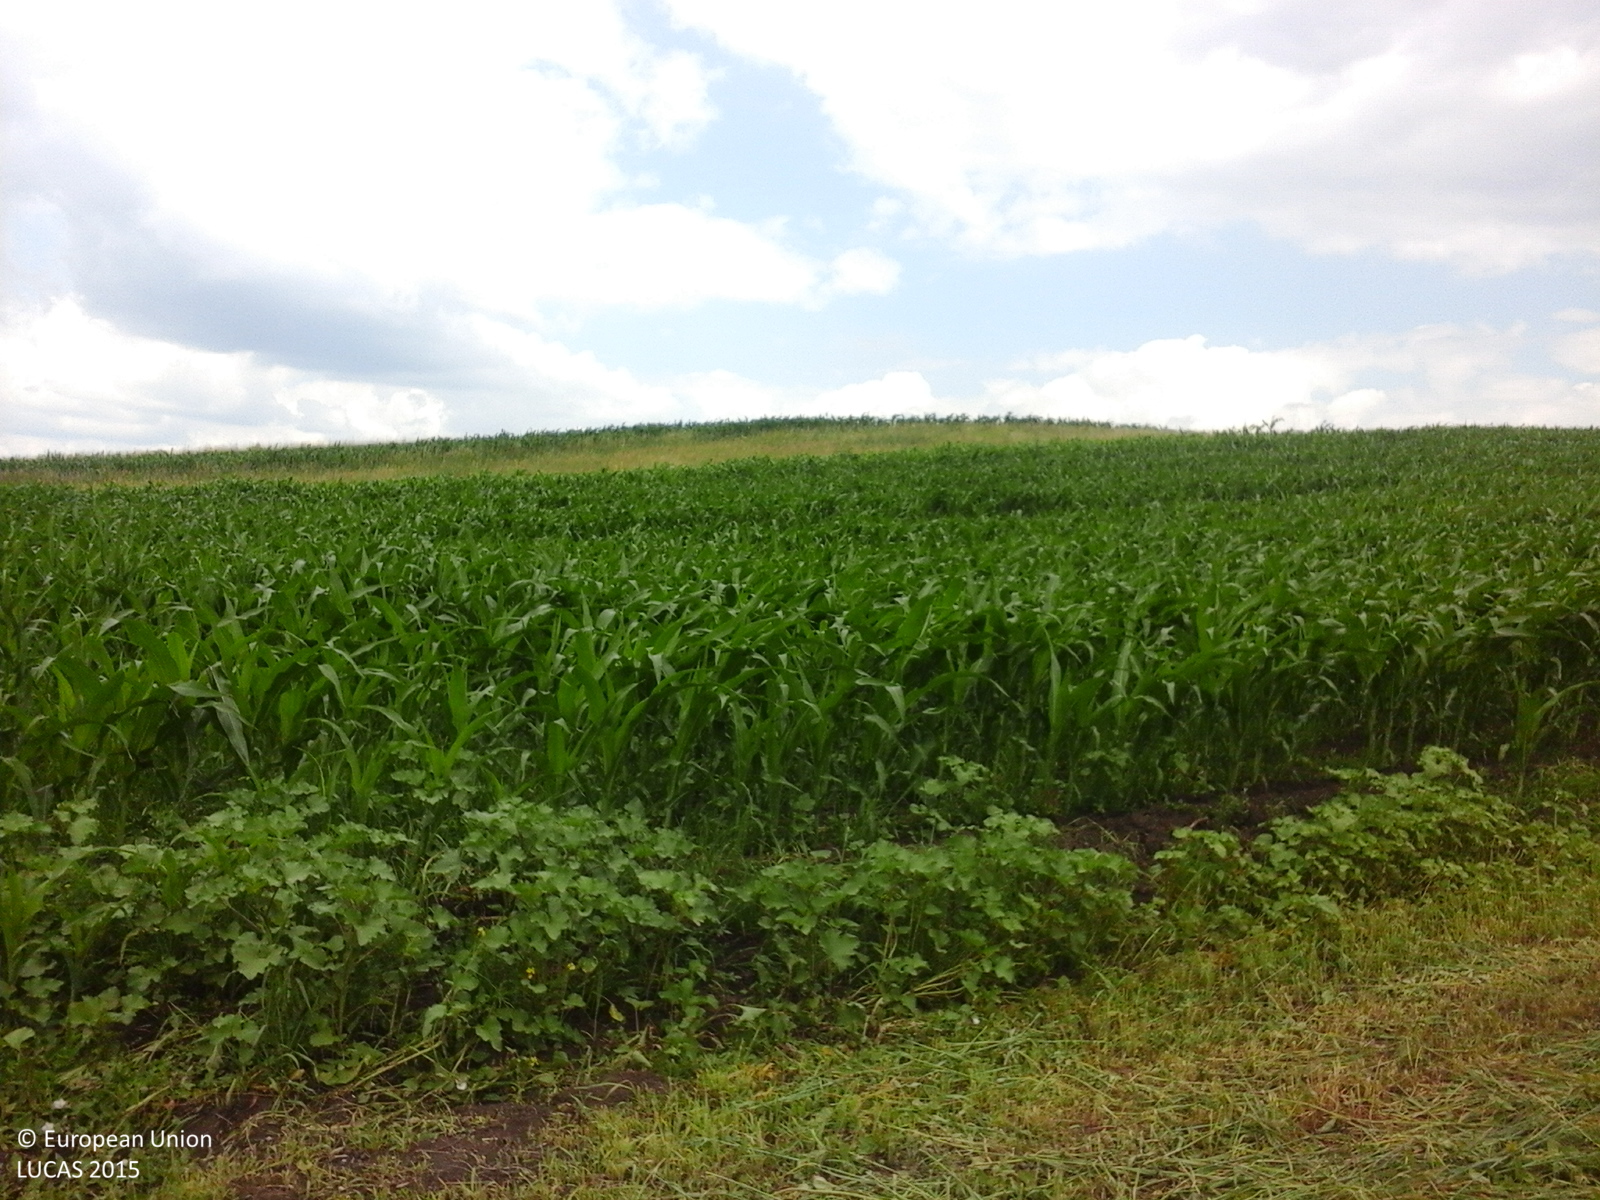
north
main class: Cropland
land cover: Oats
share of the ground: < 10 %
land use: Agriculture (excluding fallow land and kitchen gardens)
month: June
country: RO
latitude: 48.1410
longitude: 26.6404
